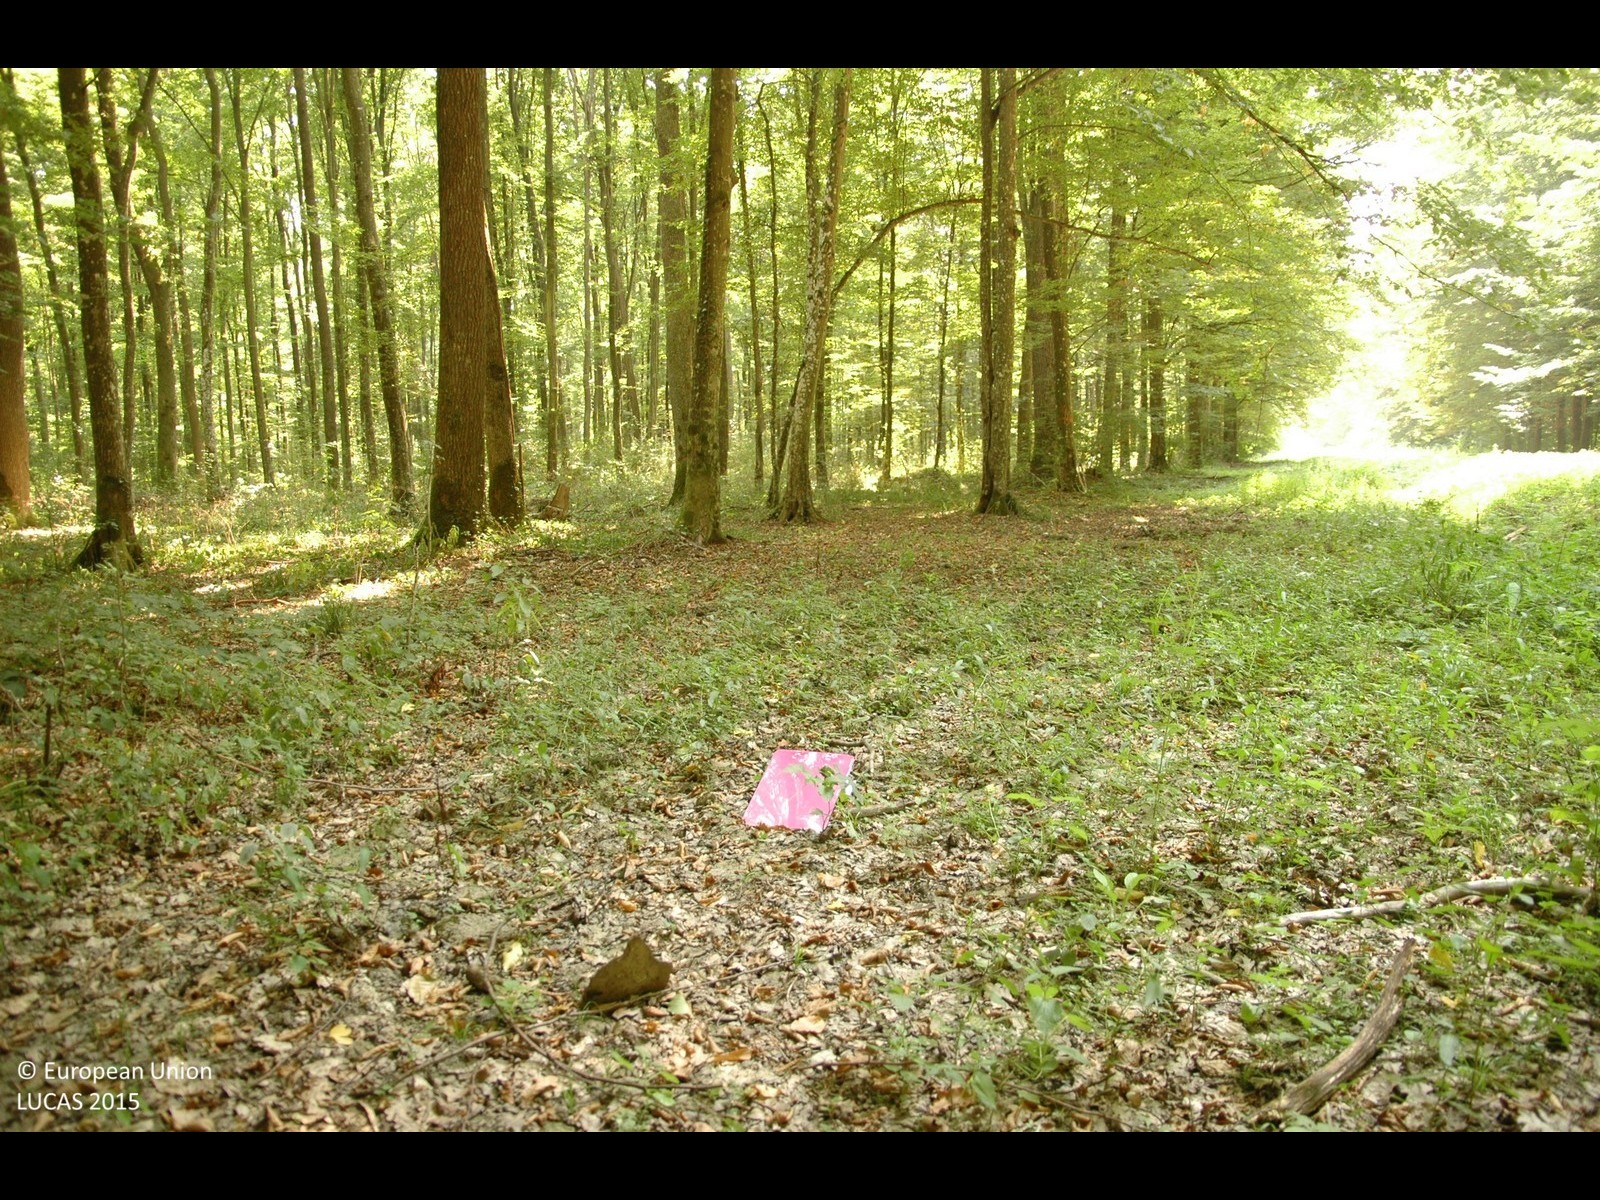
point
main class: Woodland
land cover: Broadleaved woodland
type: mesophytic deciduous forest
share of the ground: > 75 %
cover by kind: broadleaved forest trees 100 %
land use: Forestry
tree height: > 5 m
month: August
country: HR
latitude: 46.0344
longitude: 17.2248
